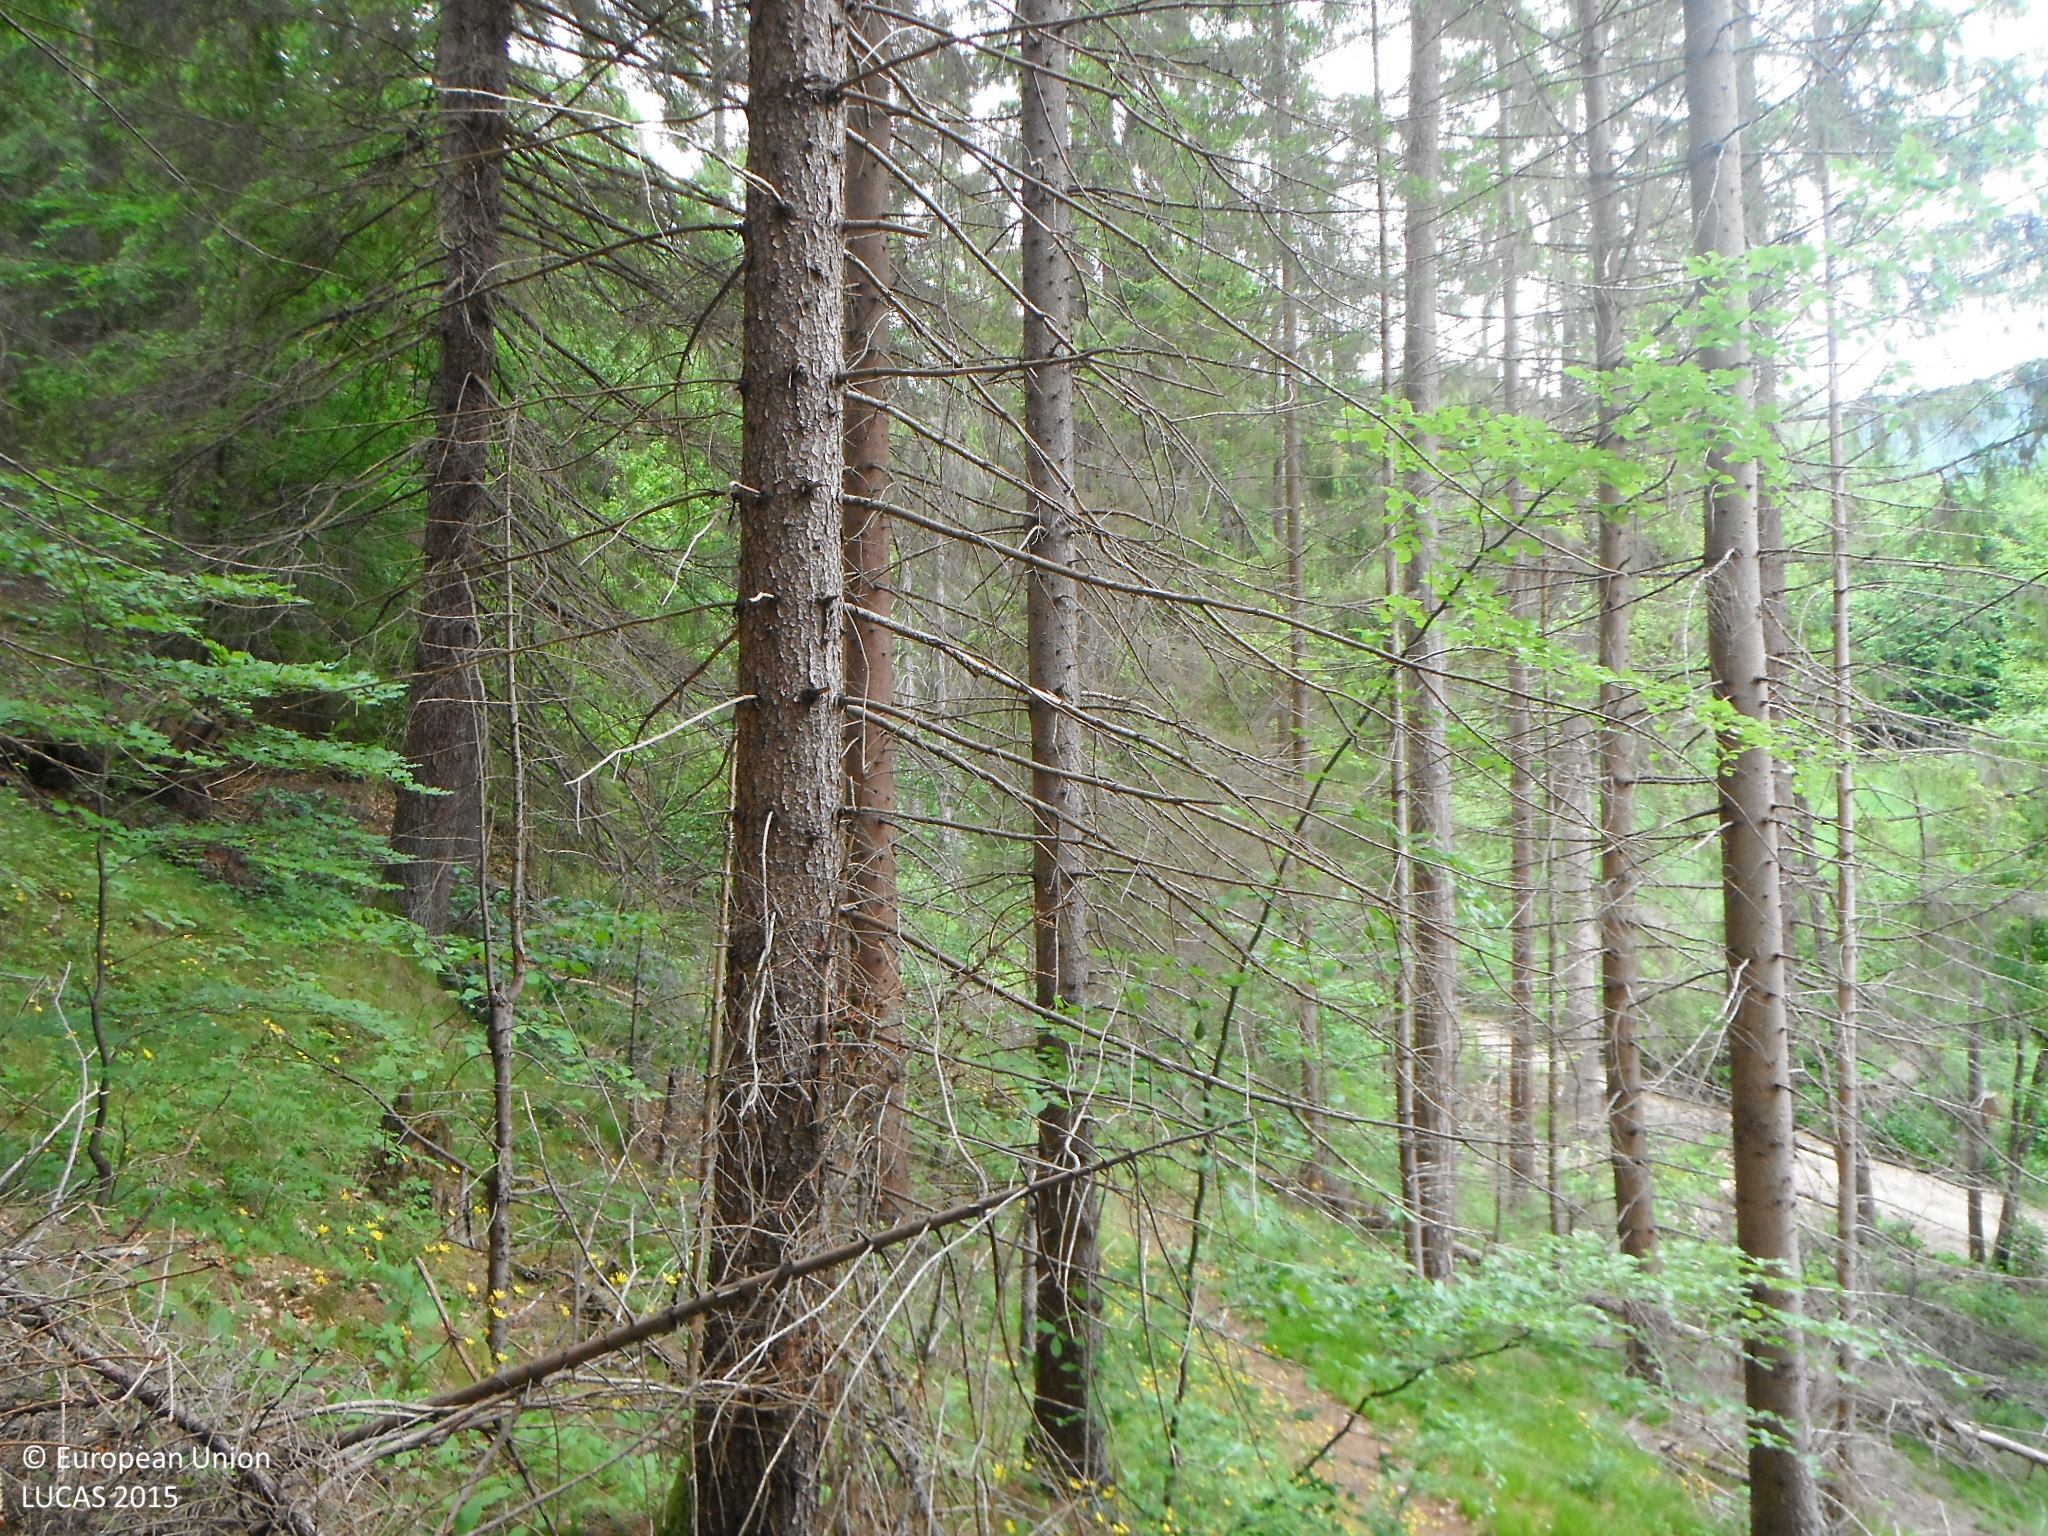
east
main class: Woodland
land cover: Spruce dominated coniferous woodland
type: alpine coniferous forest
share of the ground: > 75 %
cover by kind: coniferous forest trees 95 %, broadleaved forest trees 5 %
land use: Forestry
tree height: > 5 m
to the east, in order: Spruce dominated coniferous woodland; Tracks; Spruce dominated coniferous woodland; Spruce dominated mixed woodland
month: June
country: SK
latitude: 48.7810
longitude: 19.4013
